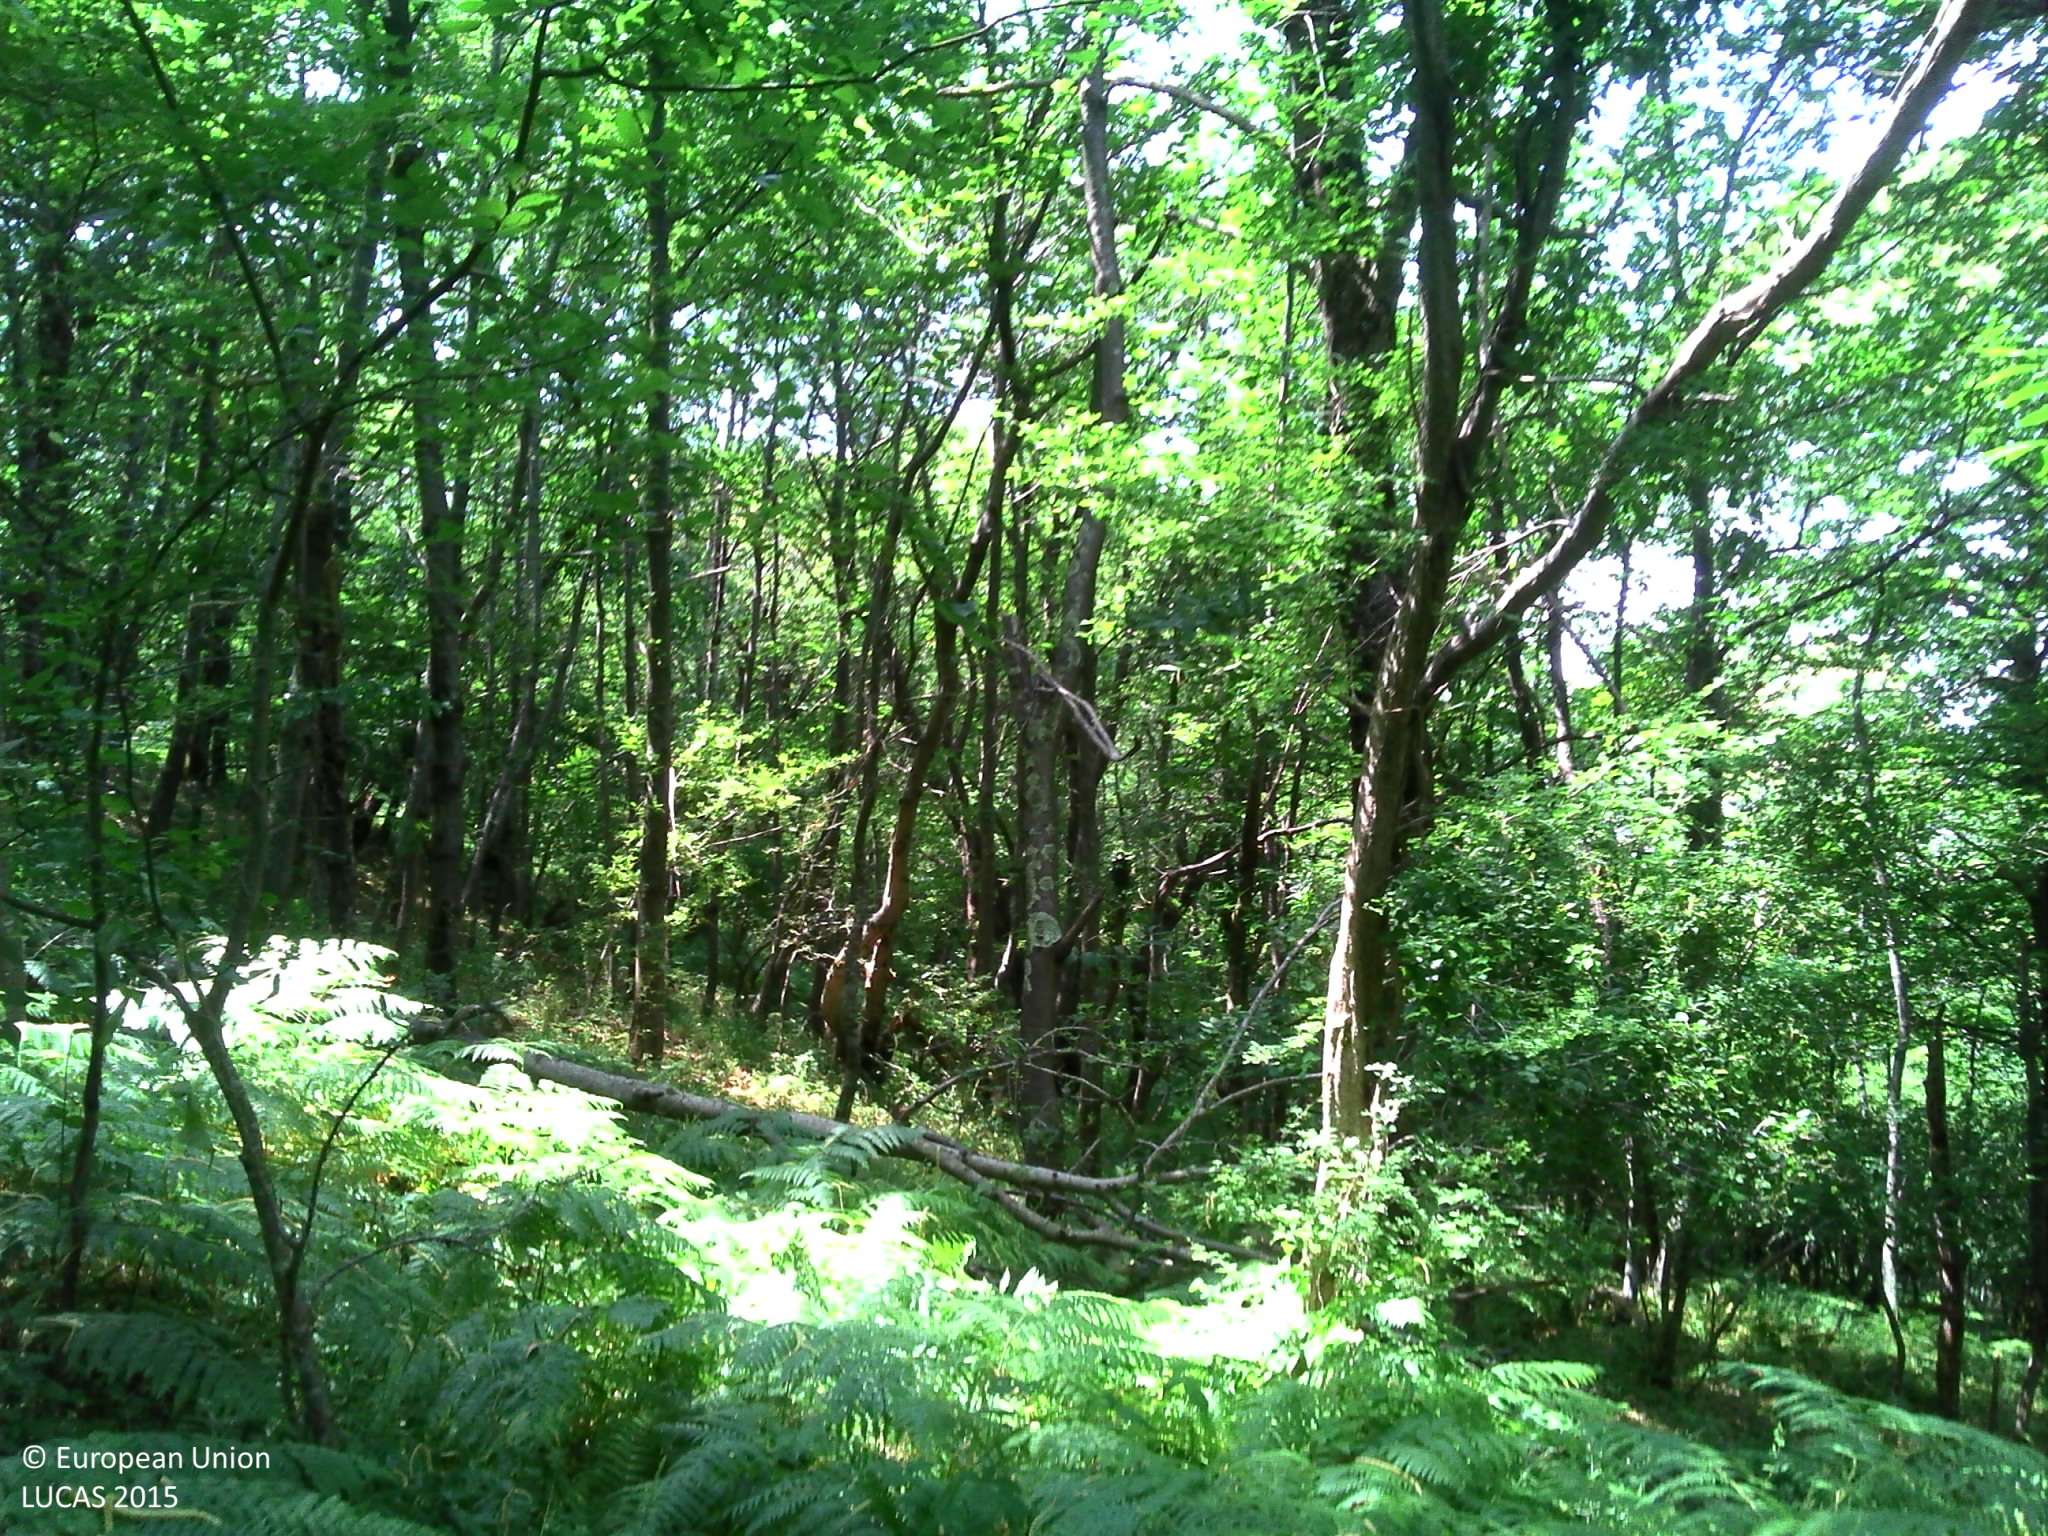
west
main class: Woodland
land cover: Broadleaved woodland
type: acidophilous oak and oak-birch forest
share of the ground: > 75 %
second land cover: Spontaneously vegetated surfaces
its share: > 75 %
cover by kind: broadleaved forest trees 65 %, shrubs 35 %
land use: Semi-natural and natural areas not in use
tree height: > 5 m
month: July
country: FR
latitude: 43.0919
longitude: 1.4675
